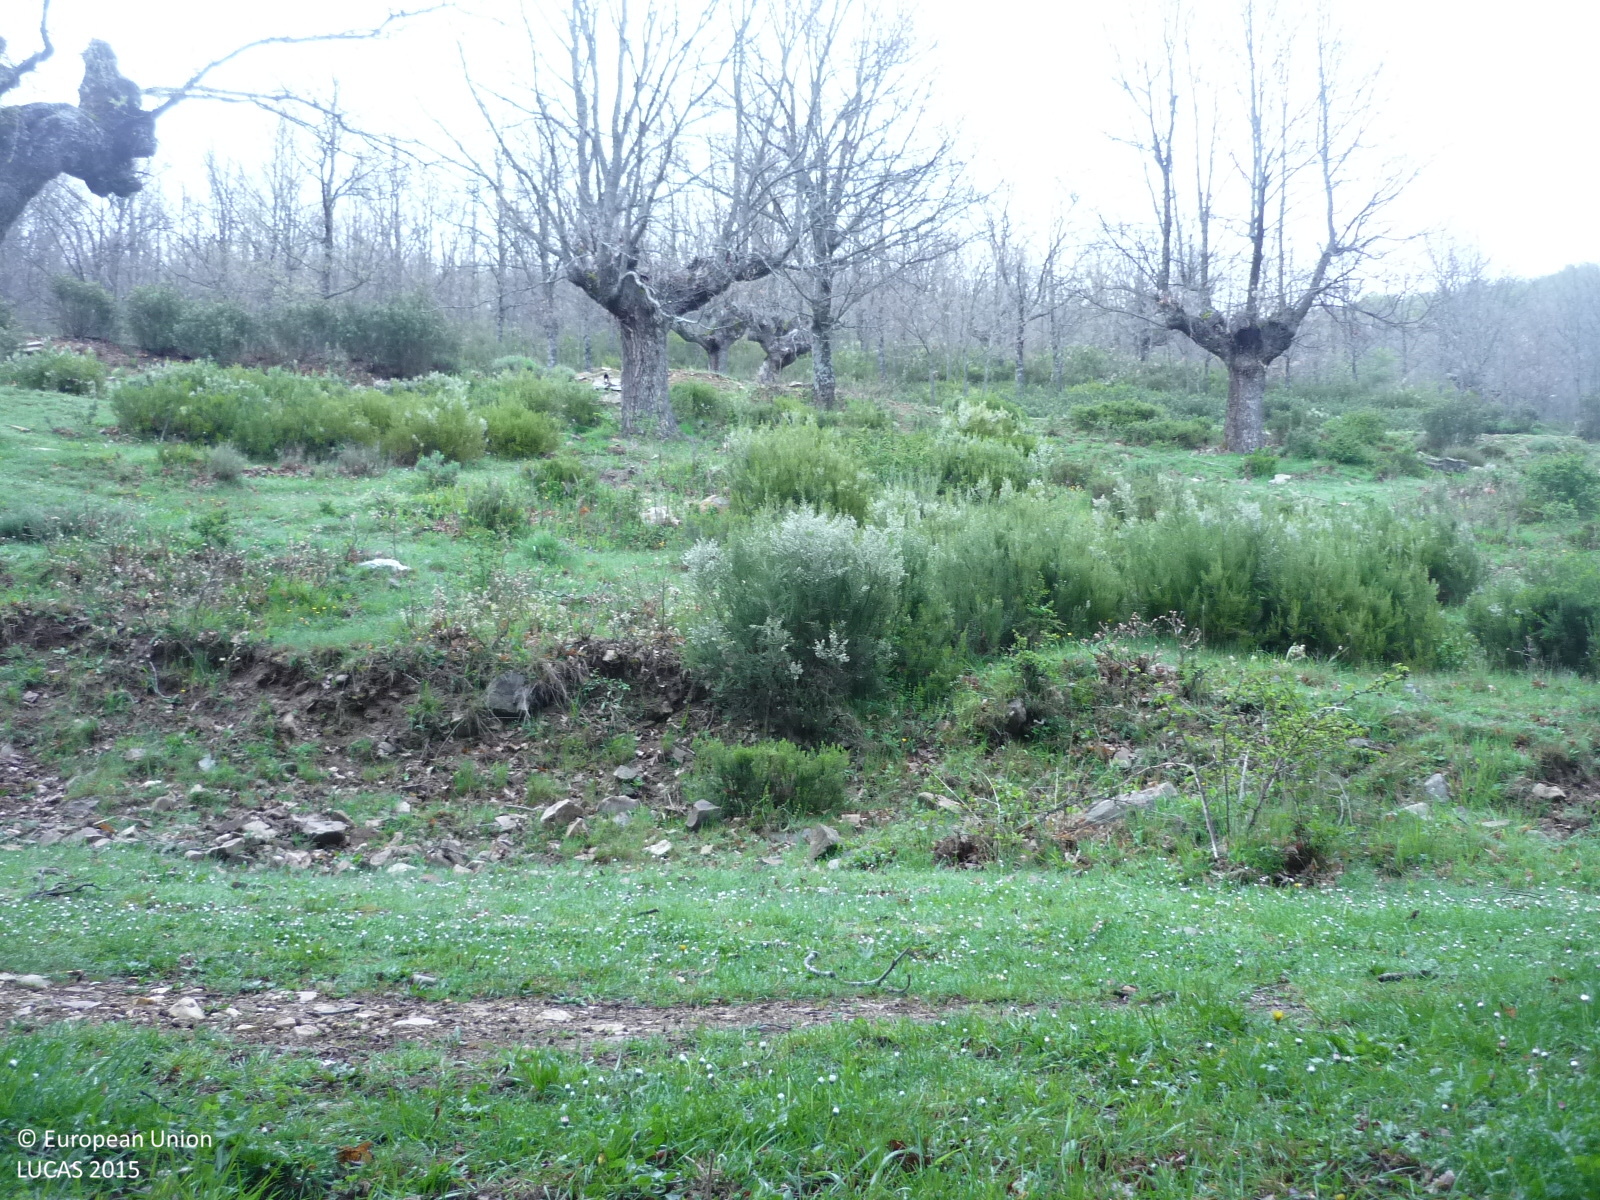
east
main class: Woodland
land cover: Broadleaved woodland
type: floodplain forest
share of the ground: > 75 %
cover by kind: broadleaved forest trees 85 %, shrubs 10 %, herbaceous plants 5 %
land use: Amenities, museums, leisure
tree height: < 5 m
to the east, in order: Broadleaved woodland; Tracks; Broadleaved woodland; Shrubland with sparse tree cover
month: May
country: ES
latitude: 41.0038
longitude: -3.4405
